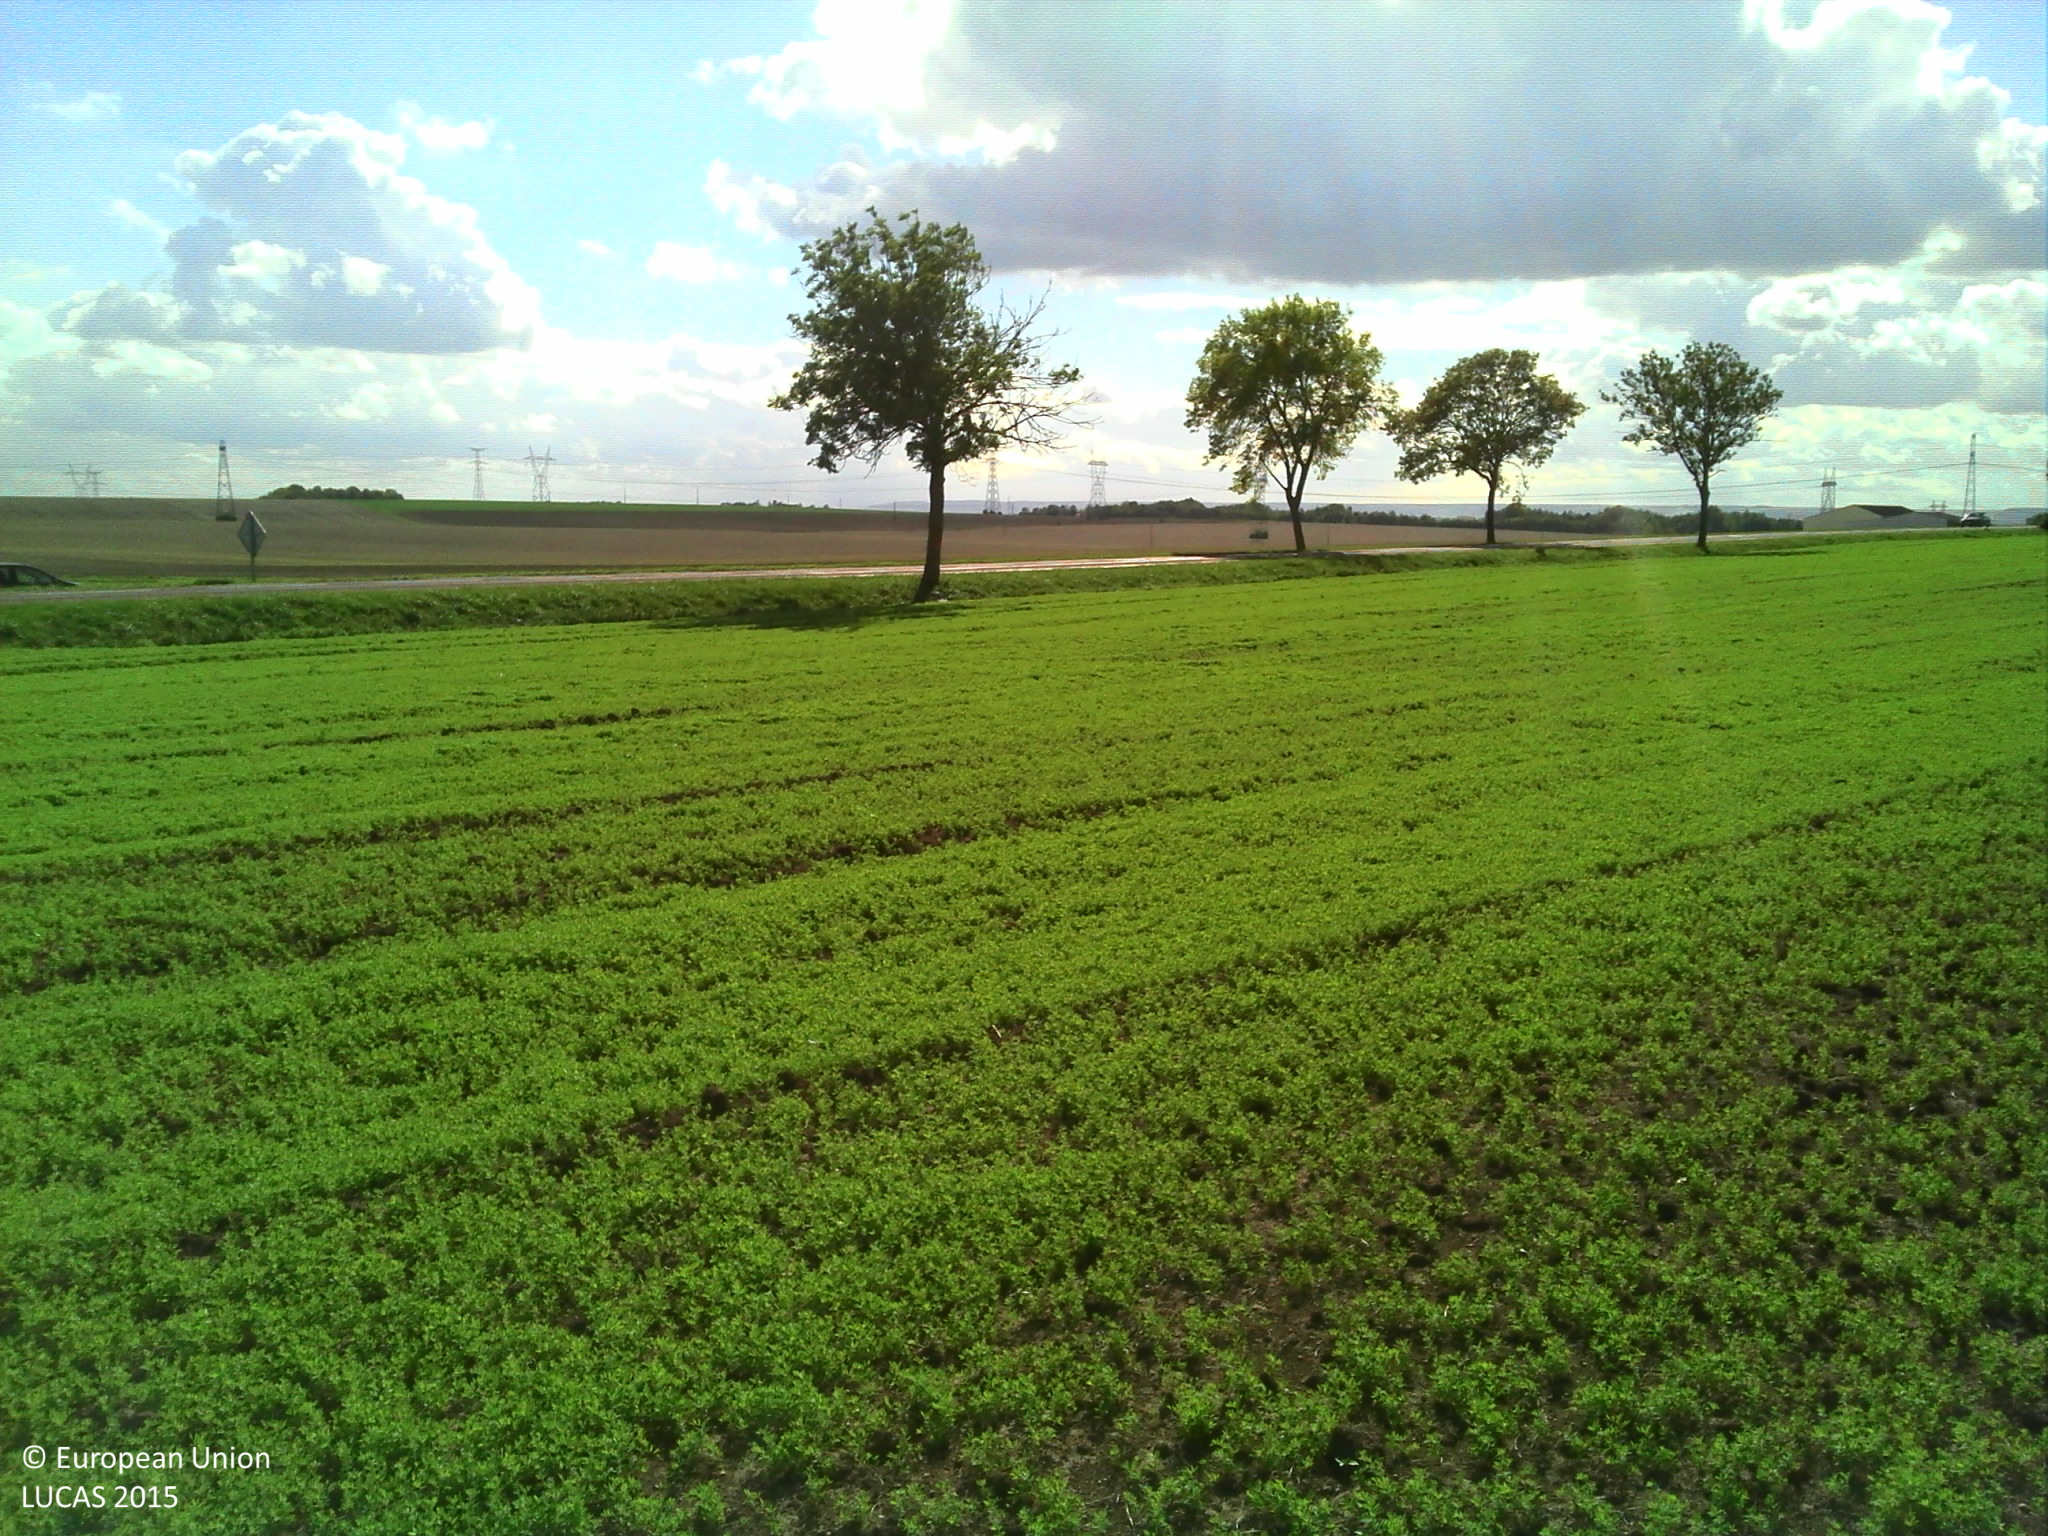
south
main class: Cropland
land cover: Dry pulses
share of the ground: 25 - 50 %
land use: Agriculture (excluding fallow land and kitchen gardens)
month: September
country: FR
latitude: 48.3405
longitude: 4.1818
